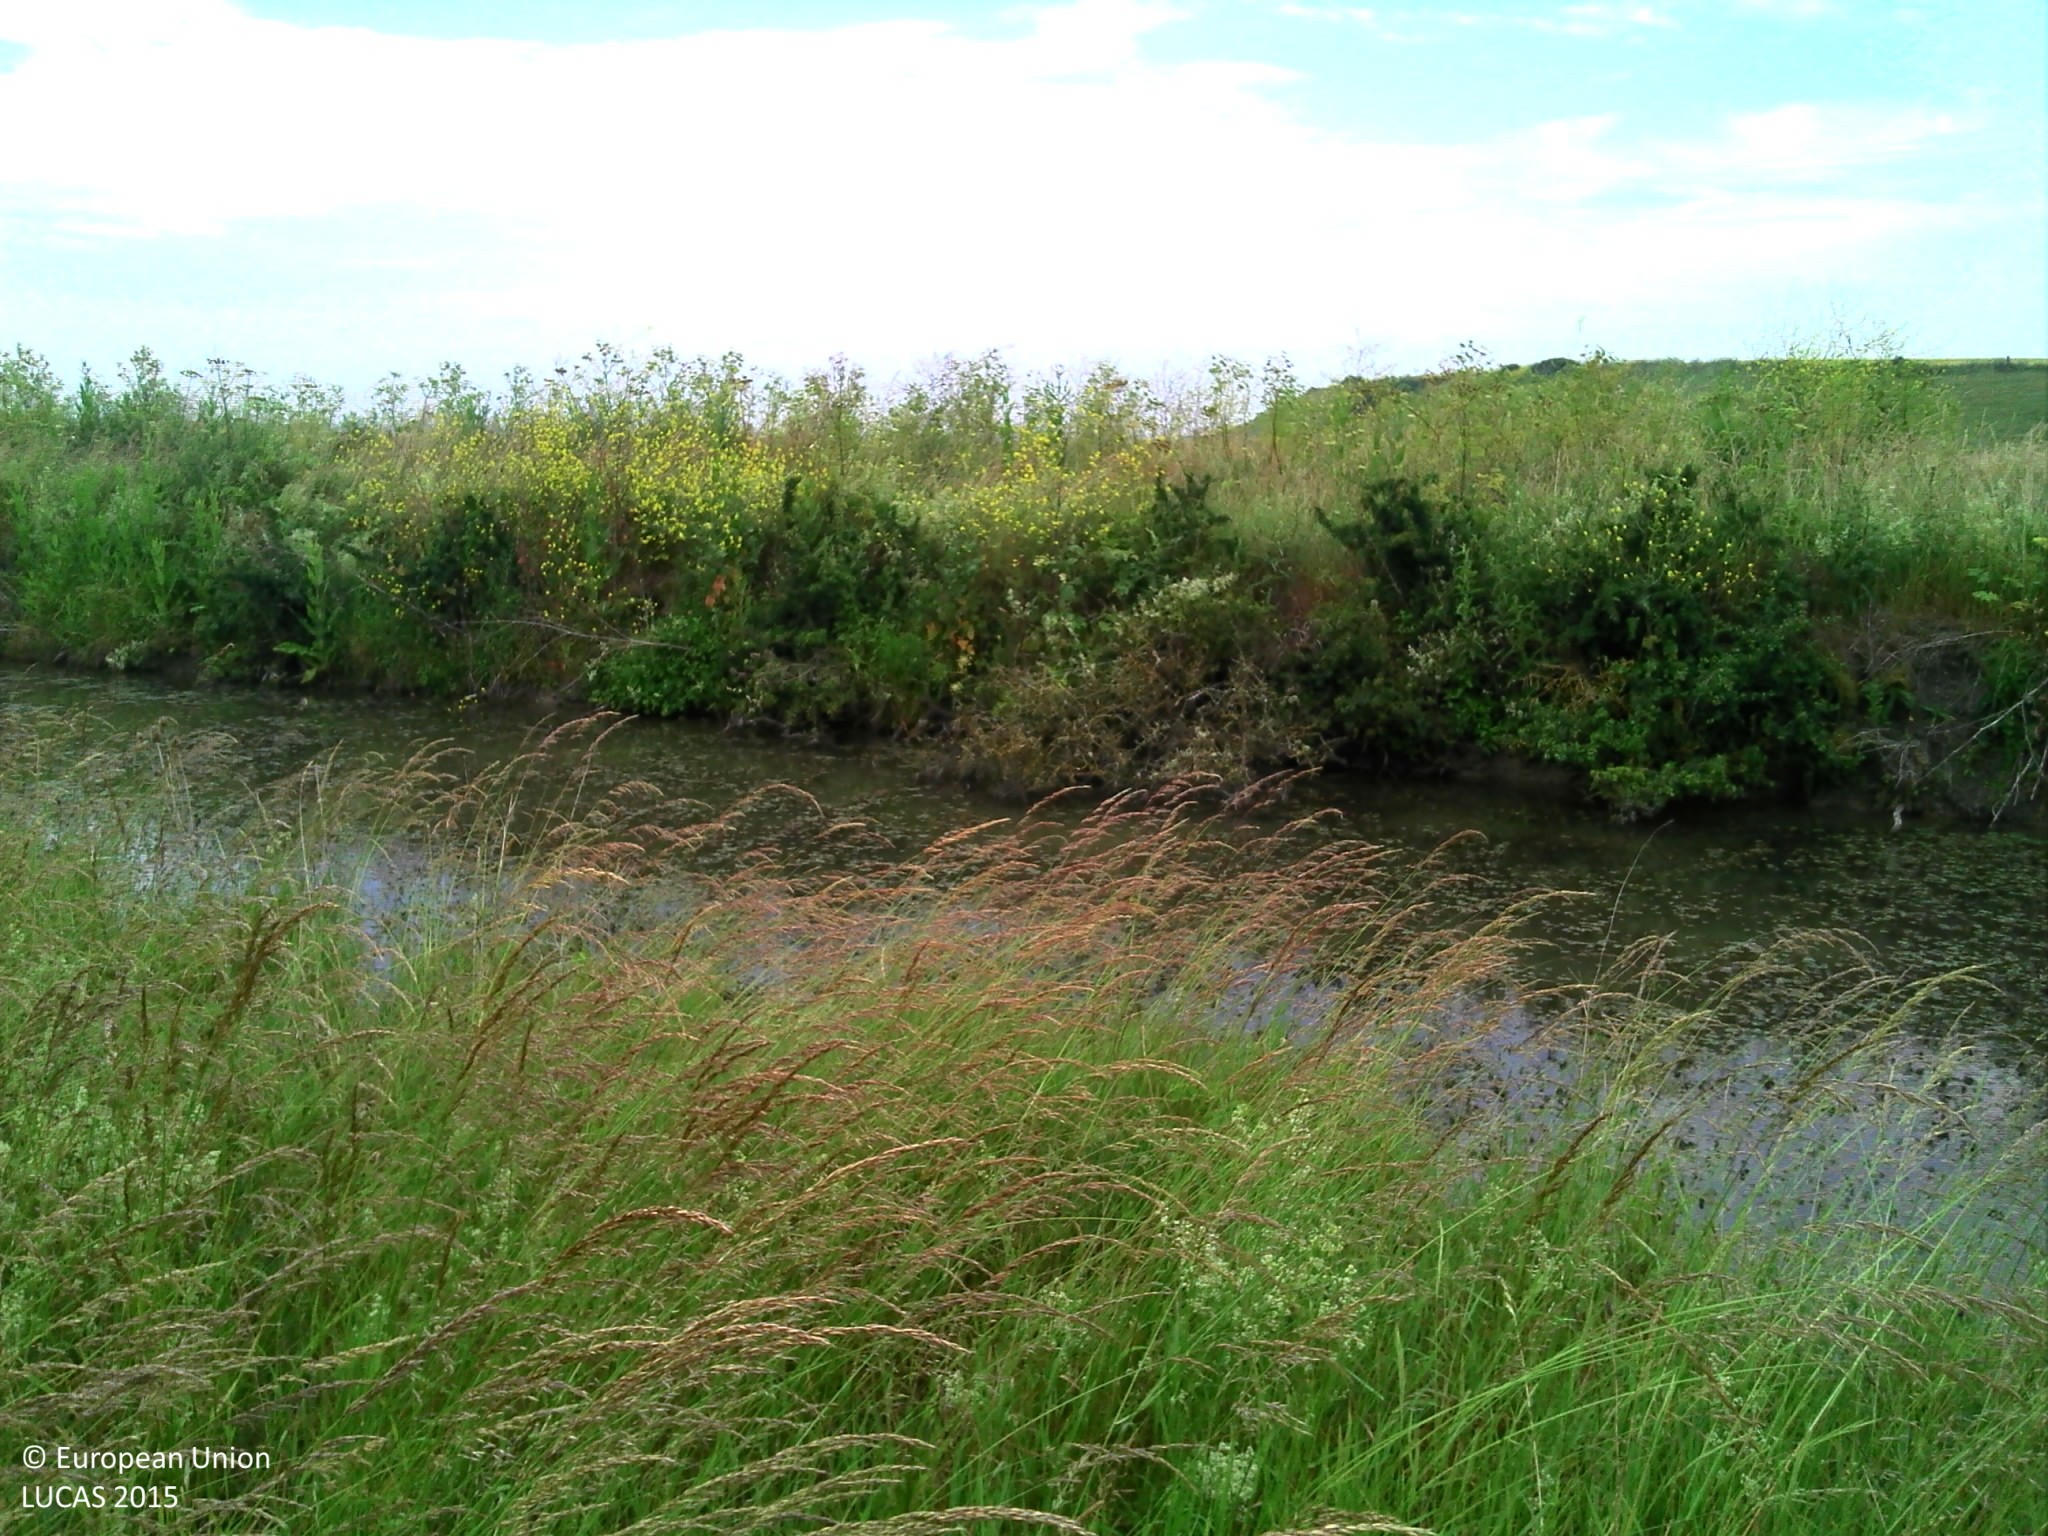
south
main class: Grassland
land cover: Grassland without tree/shrub cover
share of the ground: > 75 %
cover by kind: herbaceous plants 95 %, shrubs 5 %
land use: Agriculture (excluding fallow land and kitchen gardens)
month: June
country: FR
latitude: 46.0089
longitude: -0.9154
